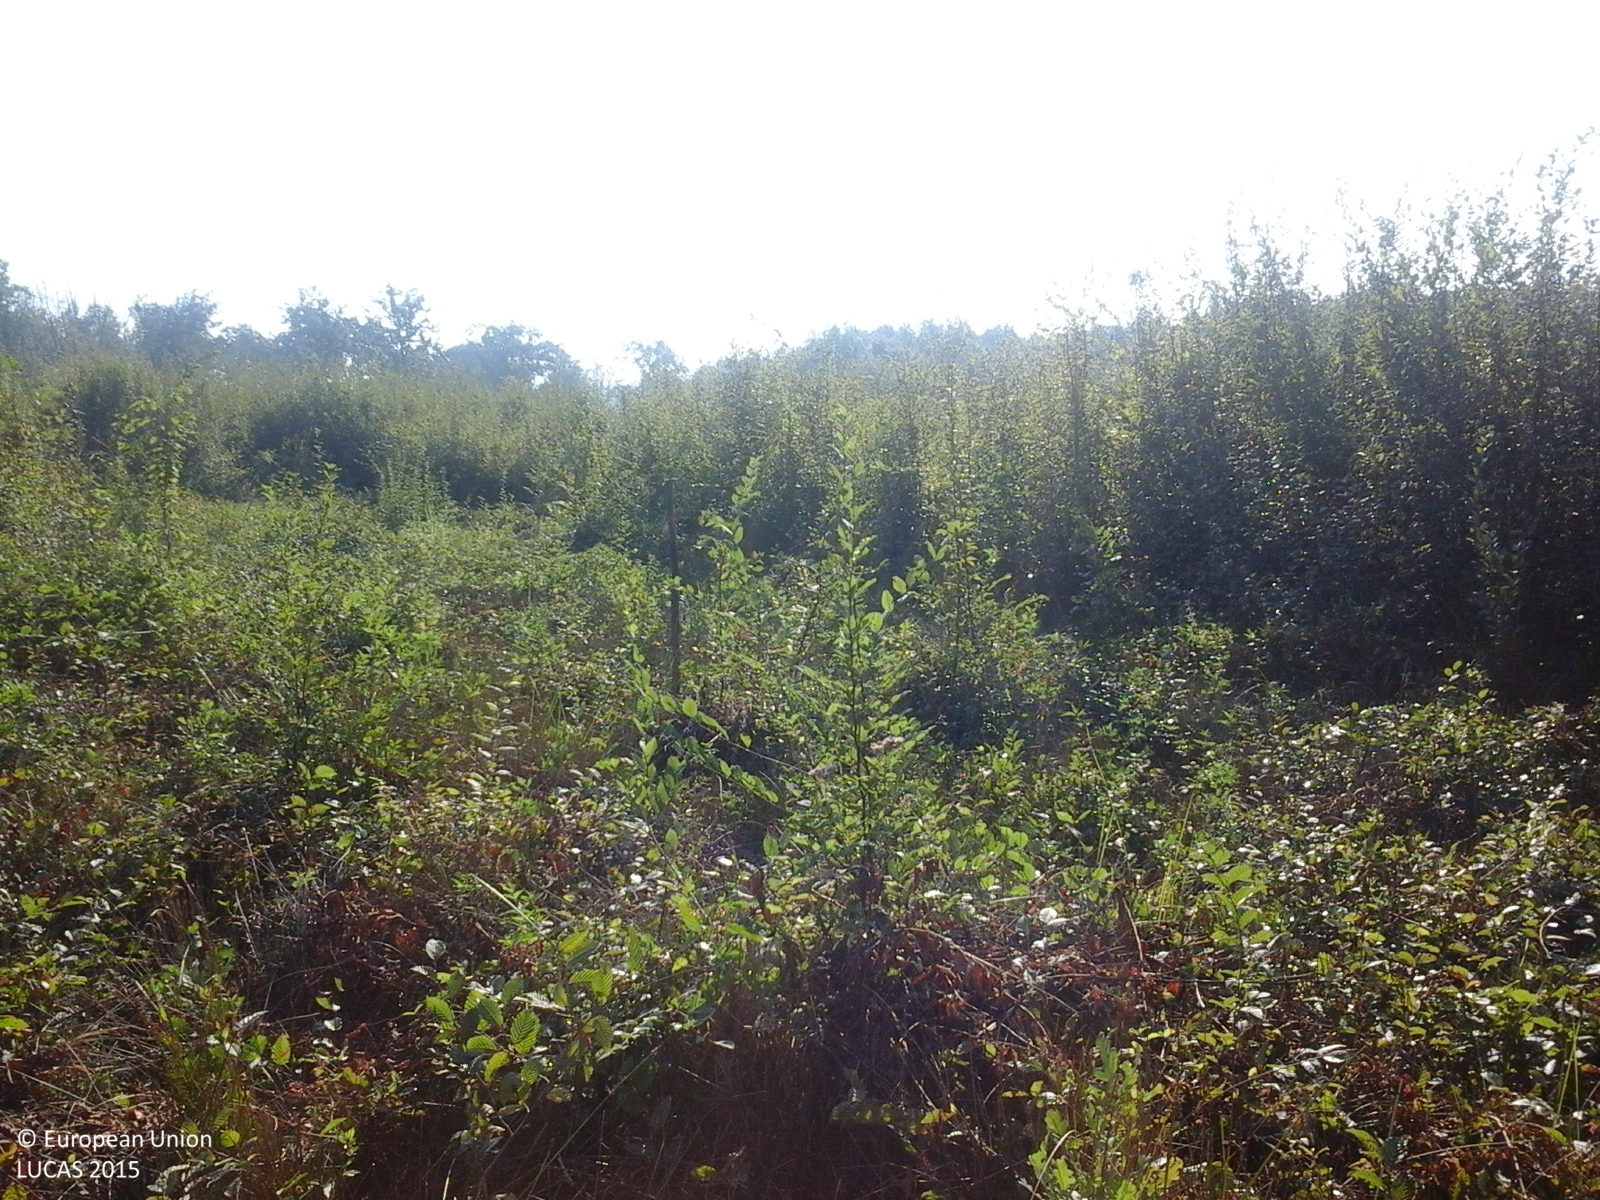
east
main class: Shrubland
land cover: Shrubland with sparse tree cover
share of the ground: > 75 %
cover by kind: herbaceous plants 75 %, shrubs 20 %, broadleaved forest trees 5 %
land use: Forestry
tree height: < 5 m
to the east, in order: Shrubland with sparse tree cover; Tracks; Shrubland with sparse tree cover; Broadleaved woodland; Tracks; Broadleaved woodland
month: August
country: RO
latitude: 46.4192
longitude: 22.1593
